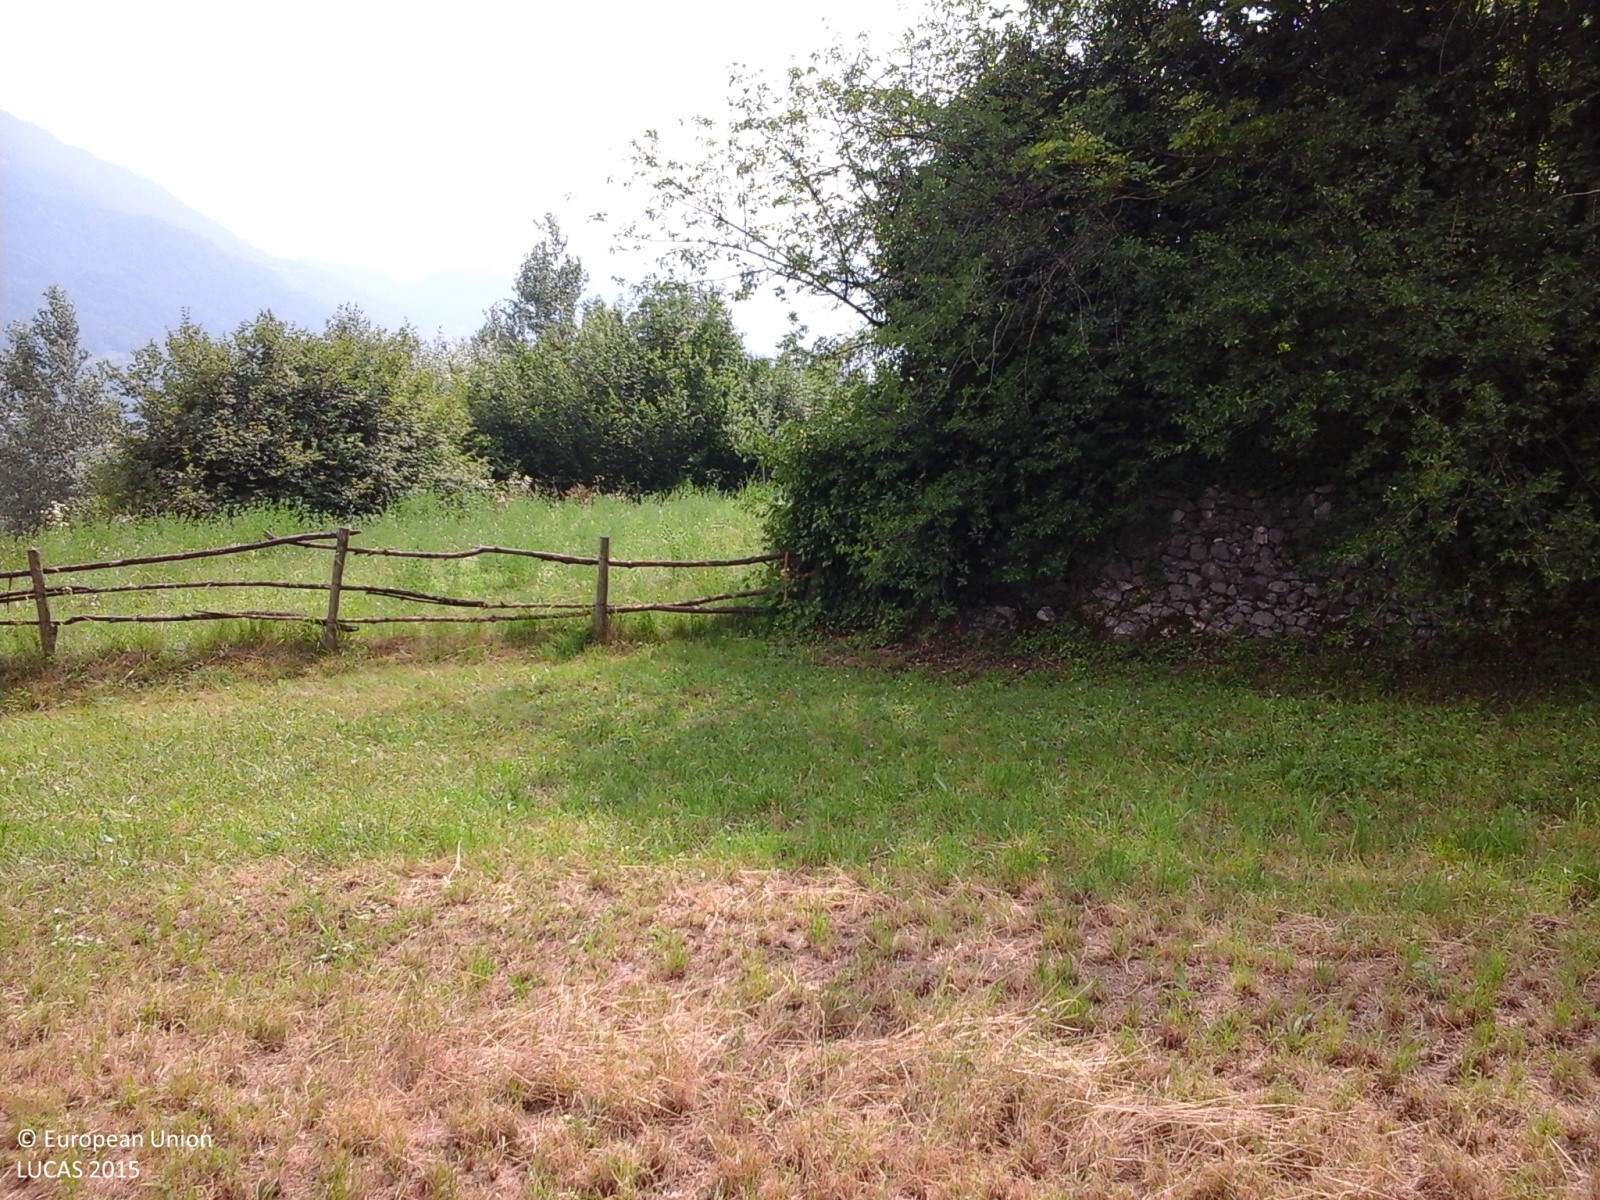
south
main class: Grassland
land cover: Grassland without tree/shrub cover
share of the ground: > 75 %
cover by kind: herbaceous plants 100 %
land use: Agriculture (excluding fallow land and kitchen gardens)
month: July
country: IT
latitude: 45.9904
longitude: 10.3223
